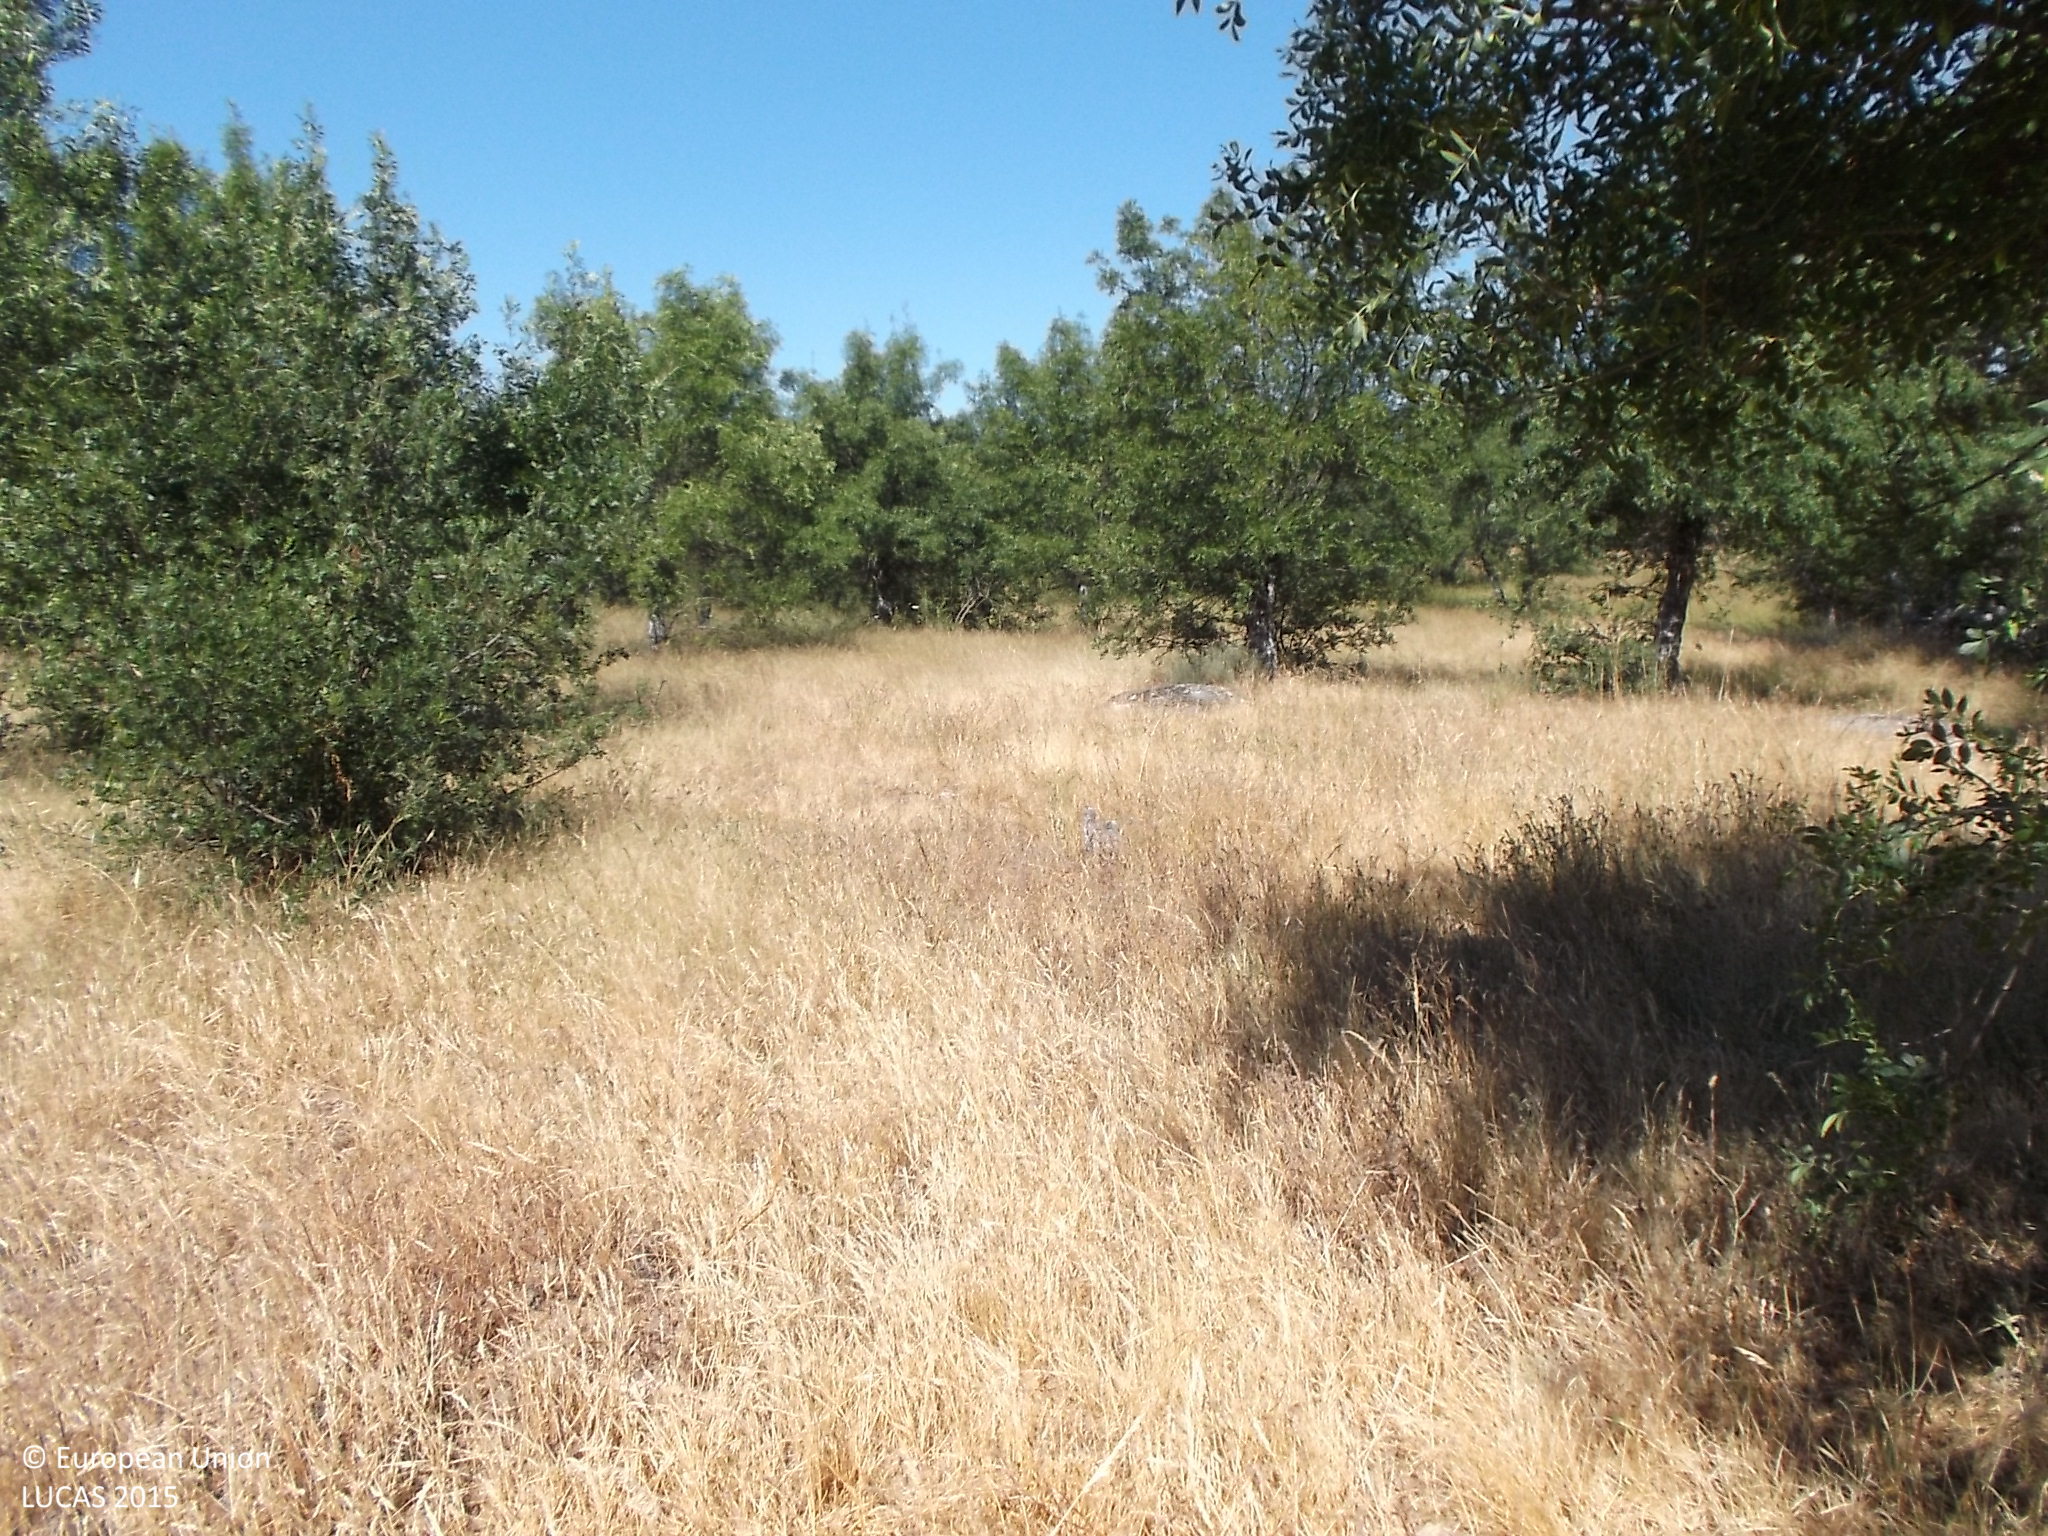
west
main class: Grassland
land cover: Grassland with sparse tree/shrub cover
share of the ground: > 75 %
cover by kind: herbaceous plants 90 %, broadleaved forest trees 5 %, shrubs 5 %
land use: Agriculture (excluding fallow land and kitchen gardens)
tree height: < 5 m
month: June
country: ES
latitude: 40.8972
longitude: -6.7531
